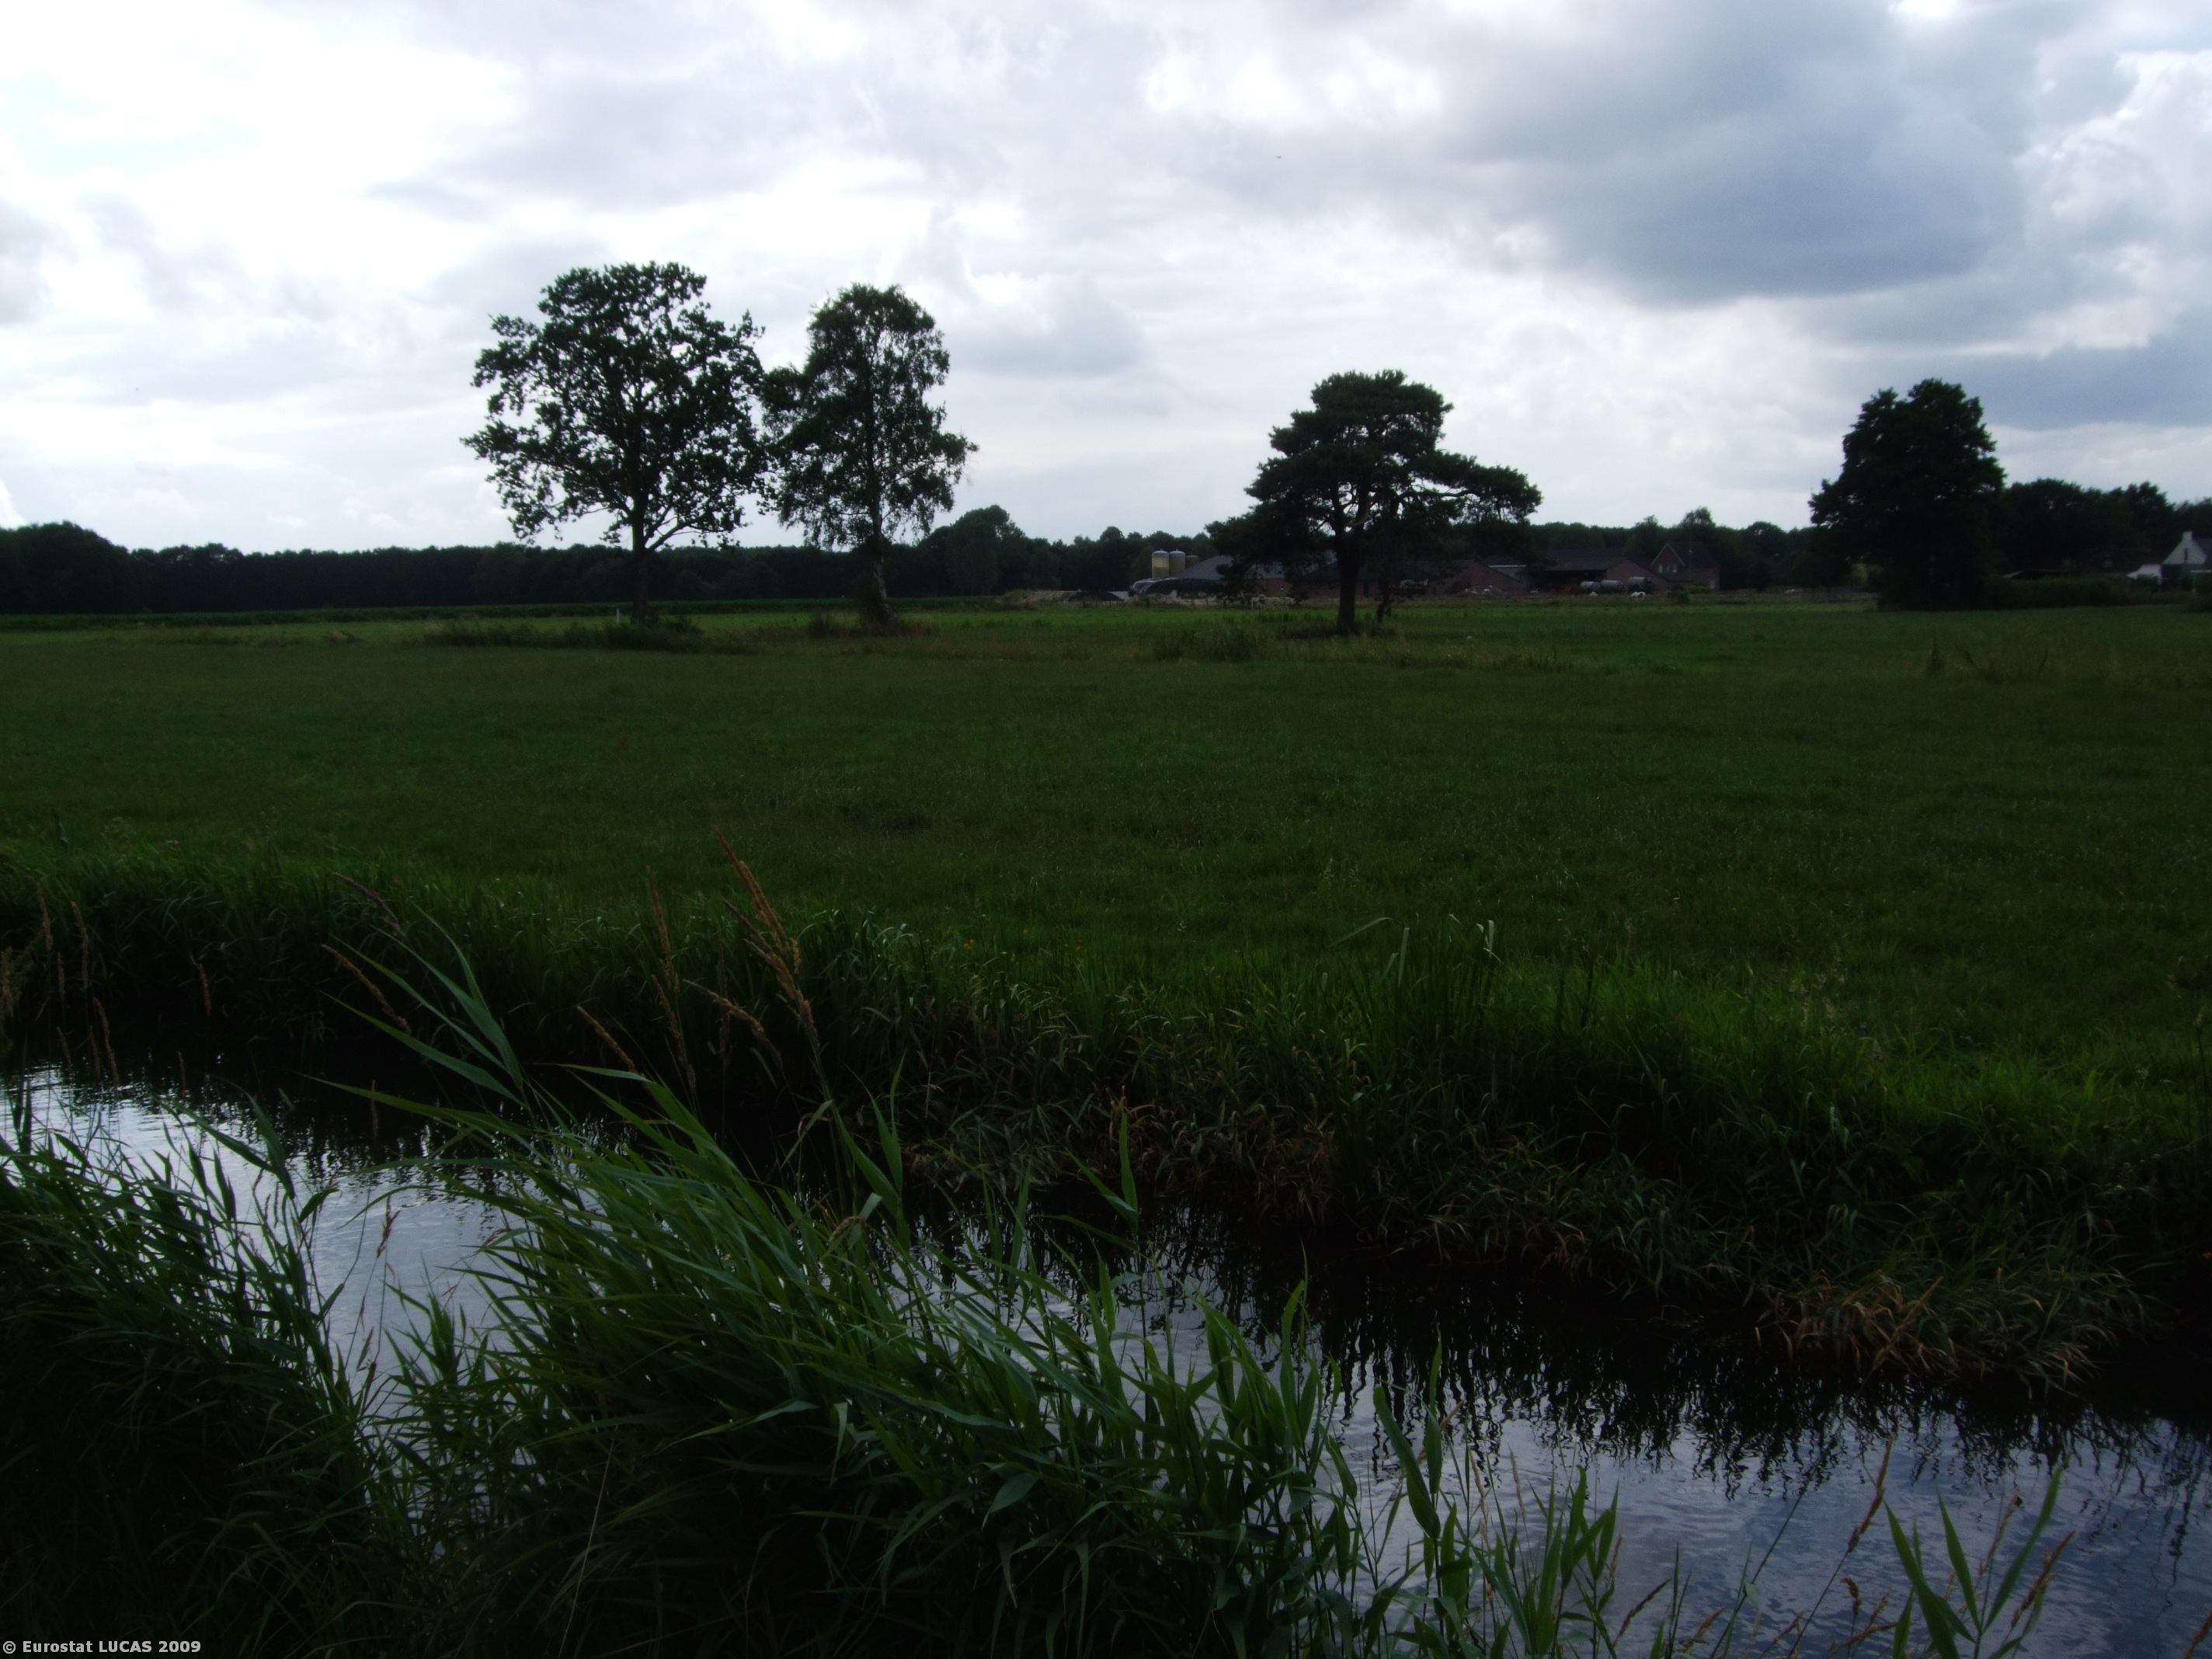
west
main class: Grassland
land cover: Grassland without tree/shrub cover
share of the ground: > 75 %
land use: Agriculture (excluding fallow land and kitchen gardens)
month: July
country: NL
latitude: 51.3371
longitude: 5.4765
